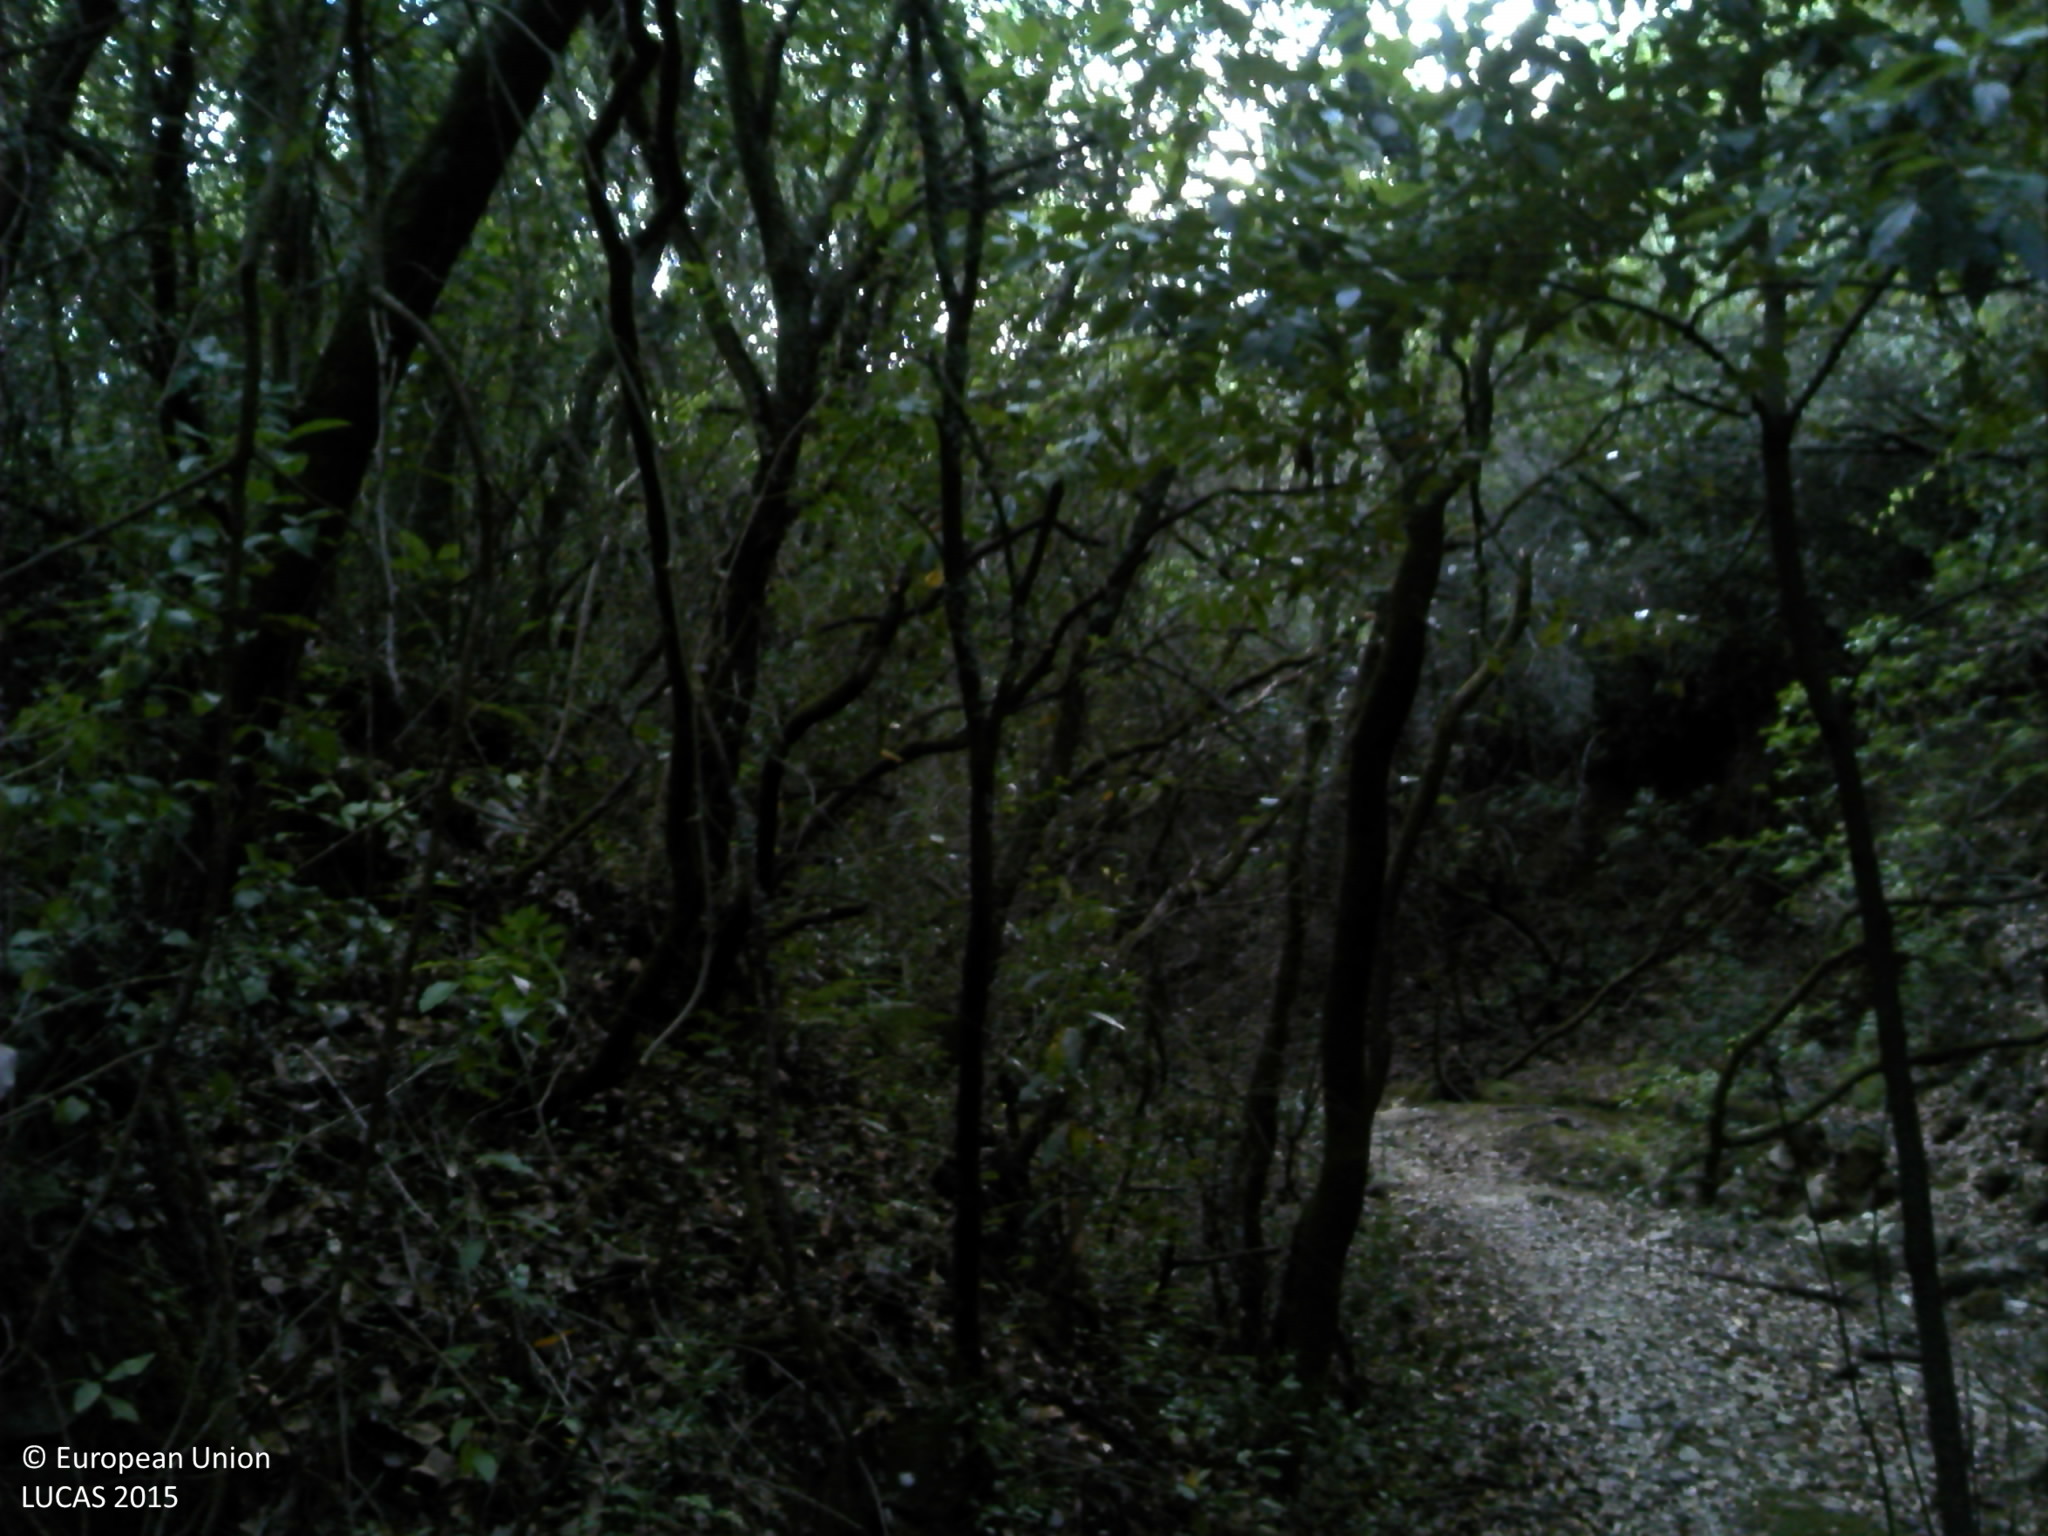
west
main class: Woodland
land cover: Broadleaved woodland
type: thermophilous deciduous forest
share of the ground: > 75 %
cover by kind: broadleaved forest trees 75 %, shrubs 25 %
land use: Semi-natural and natural areas not in use
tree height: < 5 m
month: June
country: PT
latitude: 39.0838
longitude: -9.2411
